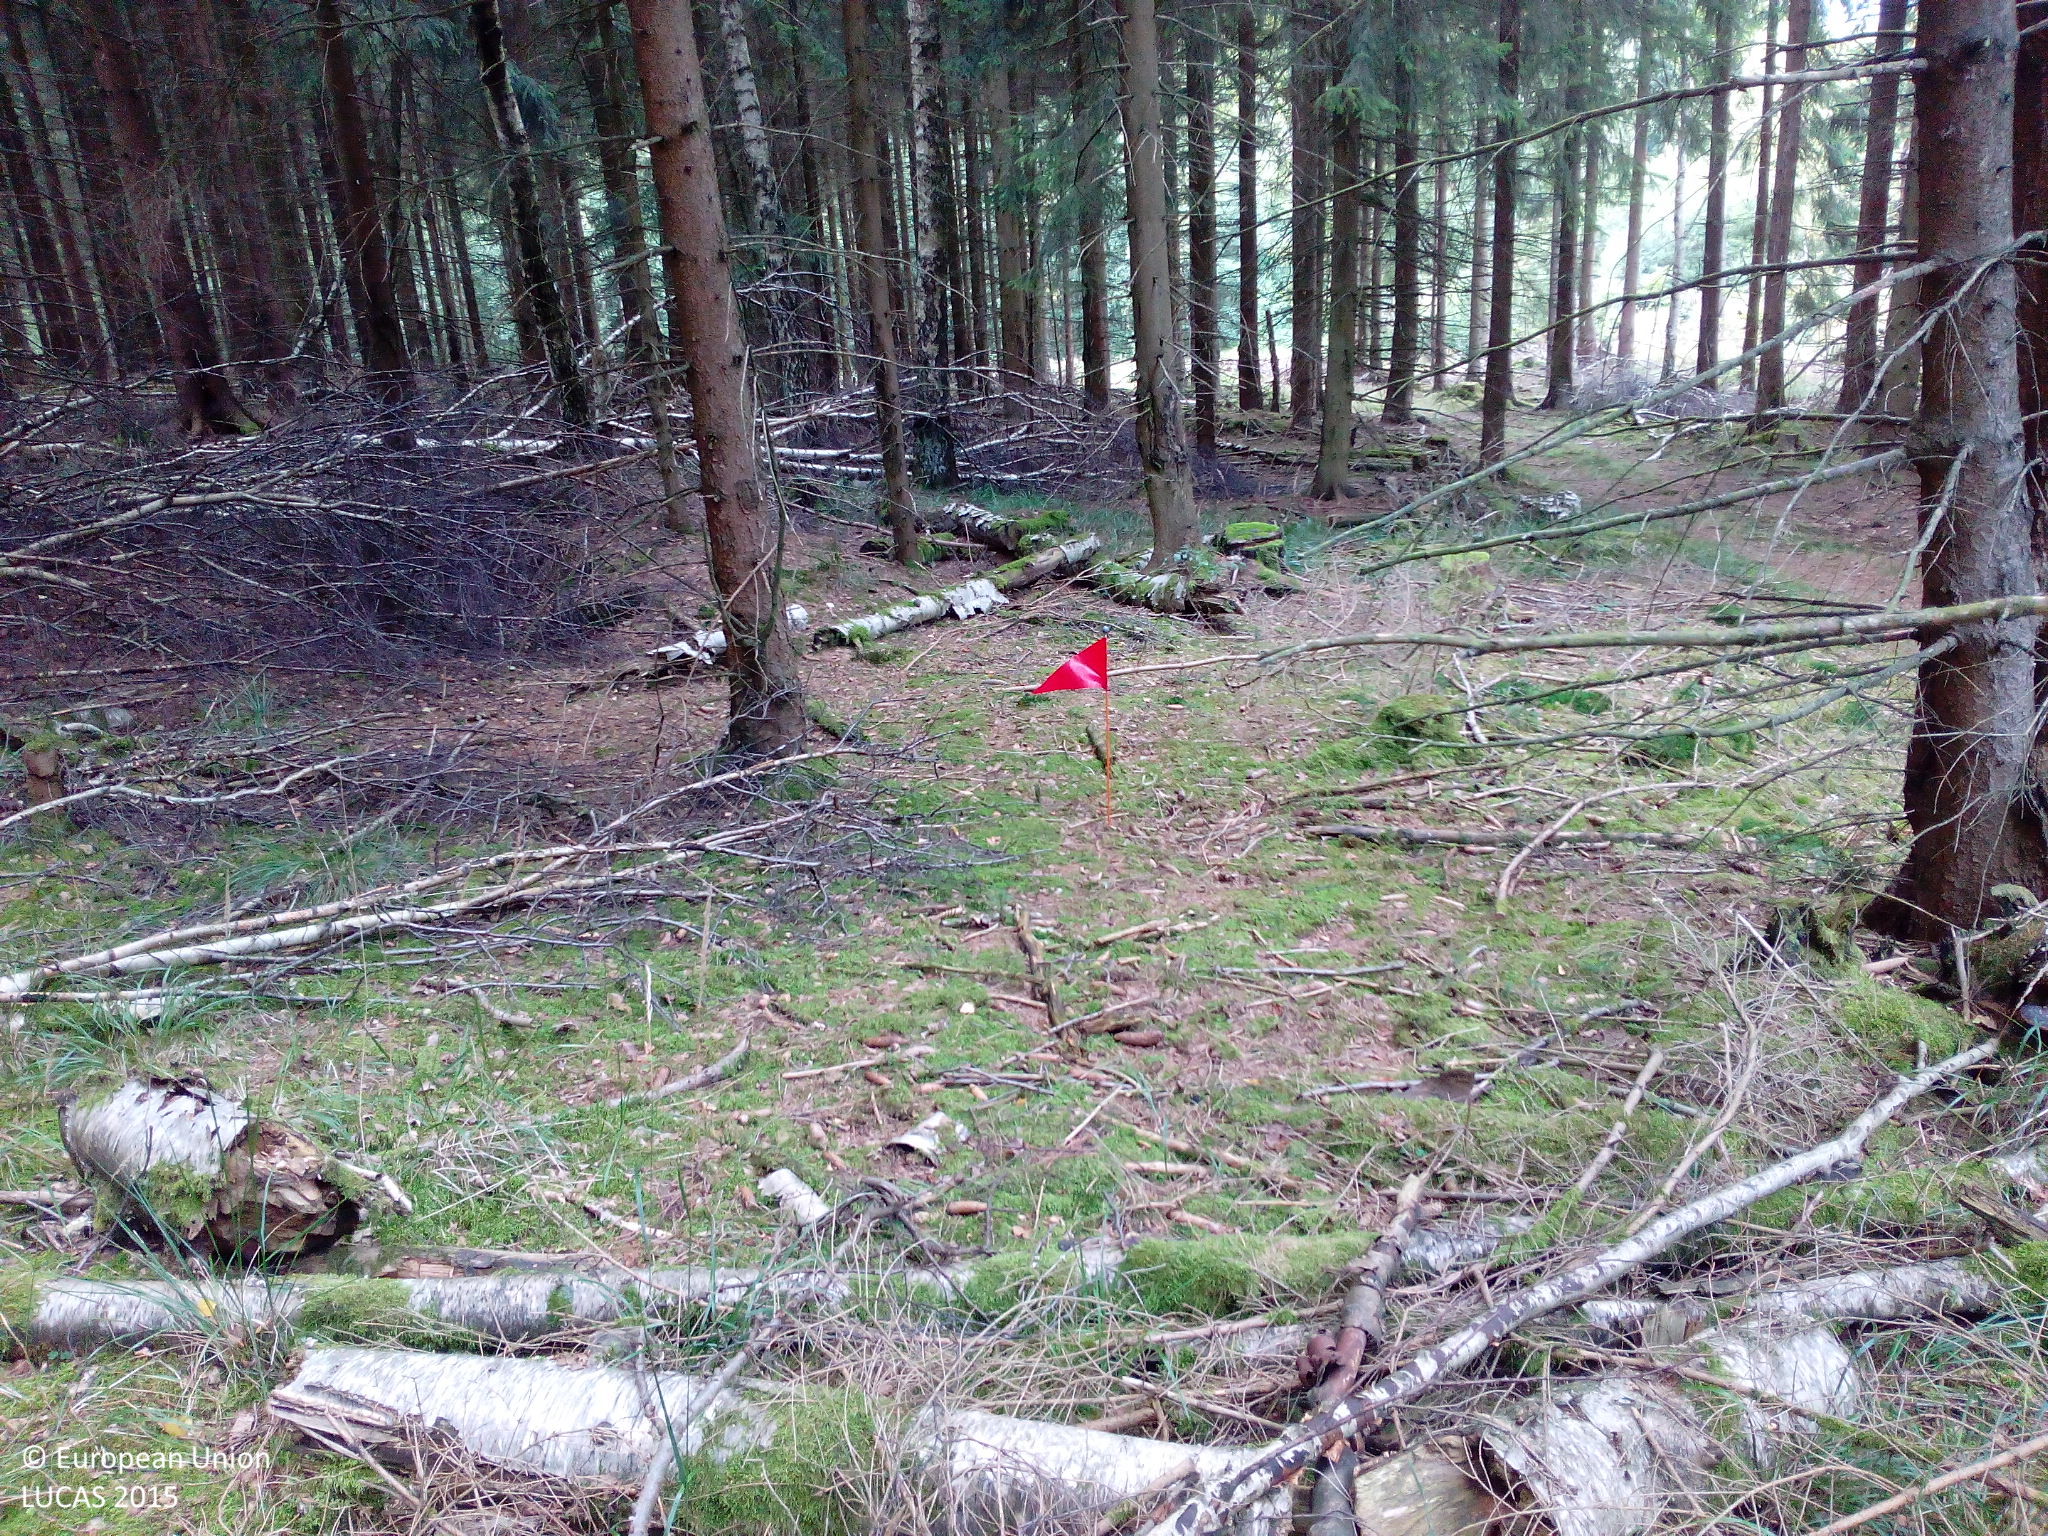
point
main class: Woodland
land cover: Spruce dominated coniferous woodland
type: hemiboreal forest and nemoral coniferous forest and mixed broadleaved-coniferous forest
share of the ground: > 75 %
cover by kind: coniferous forest trees 90 %, broadleaved forest trees 10 %
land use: Forestry
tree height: > 5 m
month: September
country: DE
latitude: 51.5821
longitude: 11.0243
